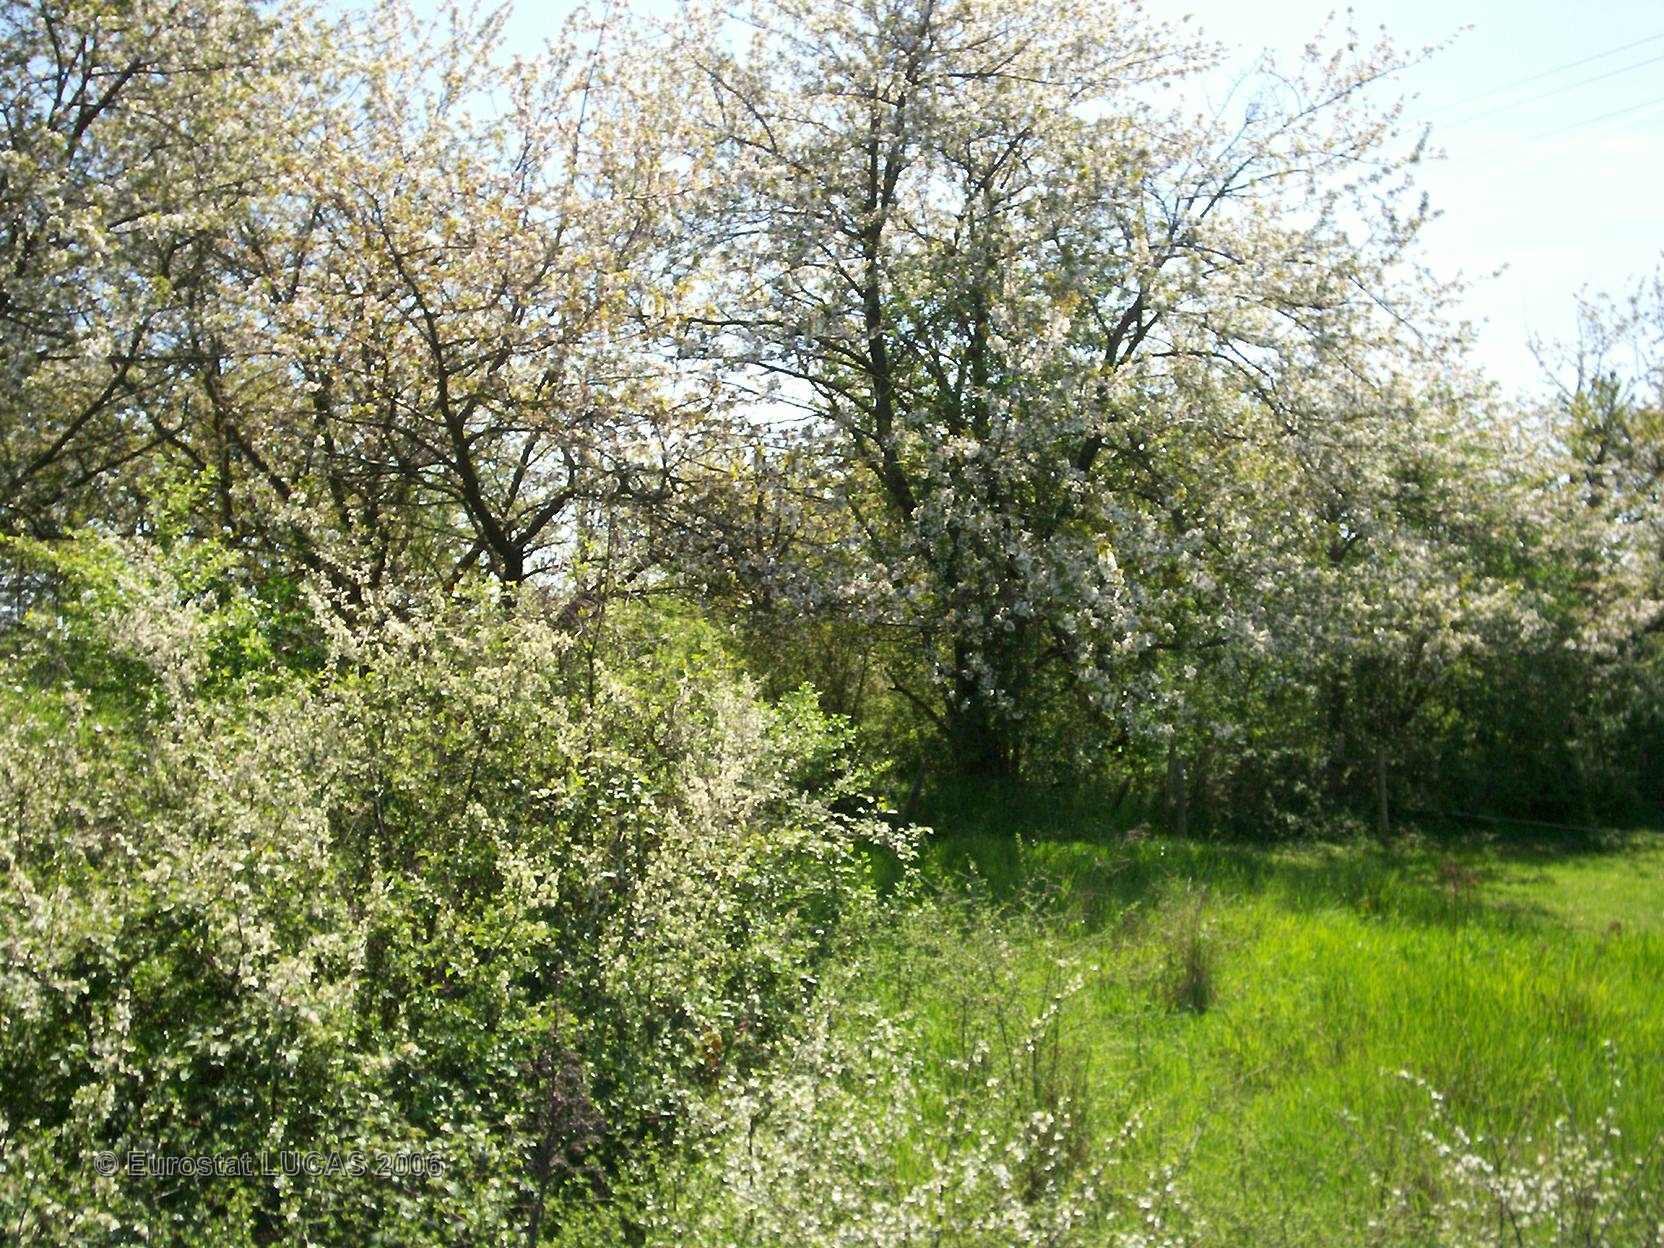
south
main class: Grassland
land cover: Grassland with sparse tree/shrub cover
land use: Agriculture (excluding fallow land and kitchen gardens)
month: April
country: FR
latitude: 45.5948
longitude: 4.8378
